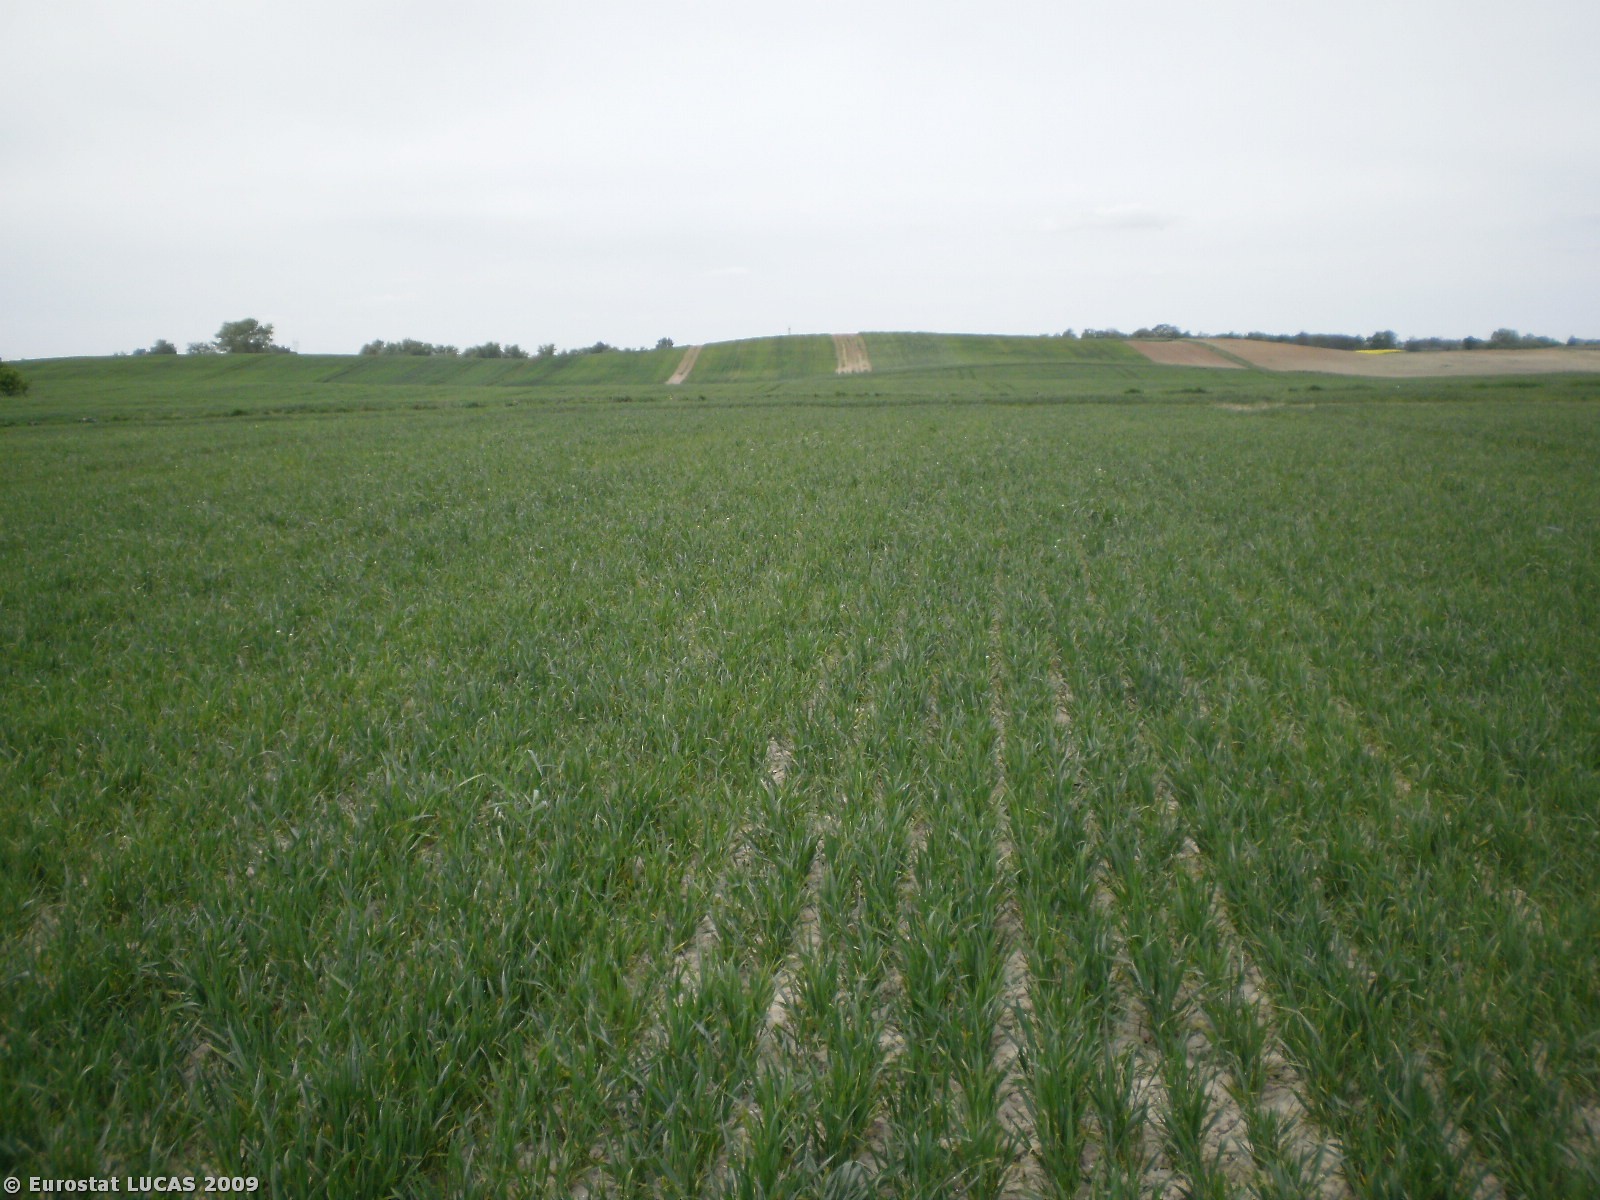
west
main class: Cropland
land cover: Common wheat
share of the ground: 50 - 75 %
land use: Agriculture (excluding fallow land and kitchen gardens)
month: May
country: PL
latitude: 53.2983
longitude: 18.7983
